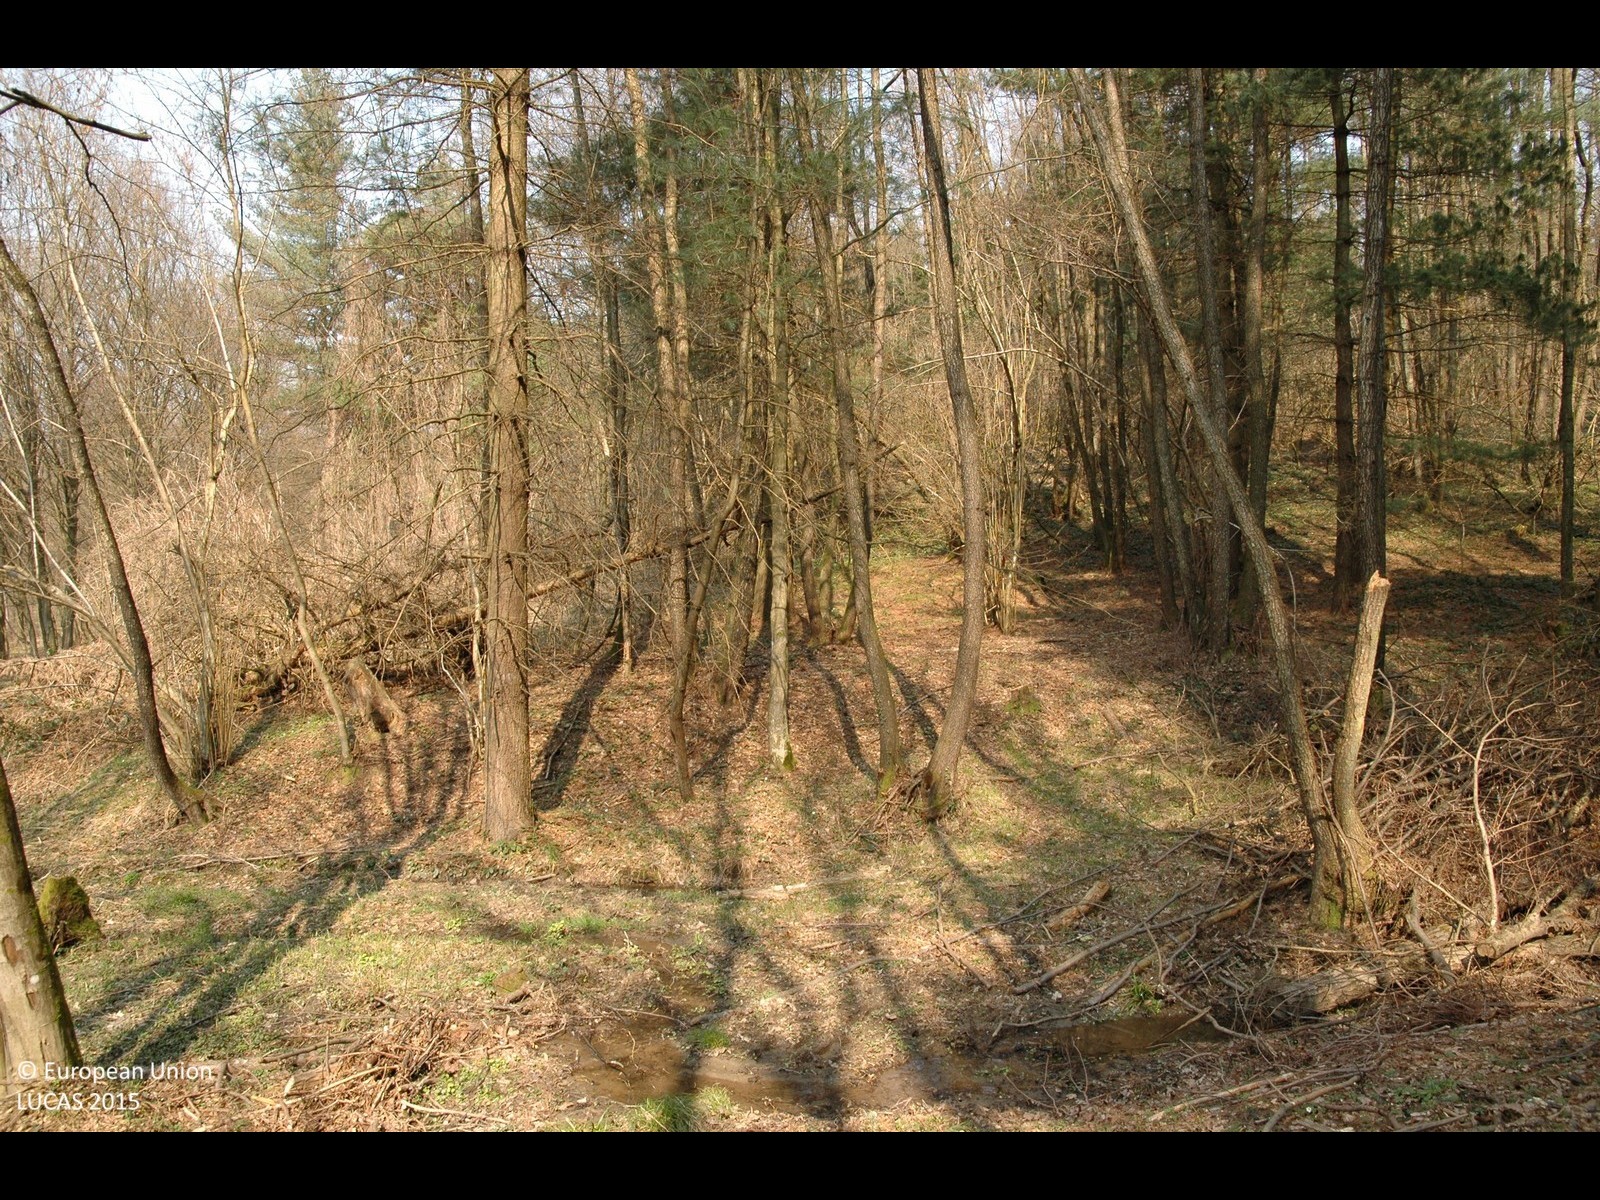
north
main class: Woodland
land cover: Broadleaved woodland
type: mesophytic deciduous forest
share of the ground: > 75 %
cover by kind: broadleaved forest trees 95 %, coniferous forest trees 5 %
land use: Forestry
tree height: > 5 m
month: March
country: HR
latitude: 46.2470
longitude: 16.4465
